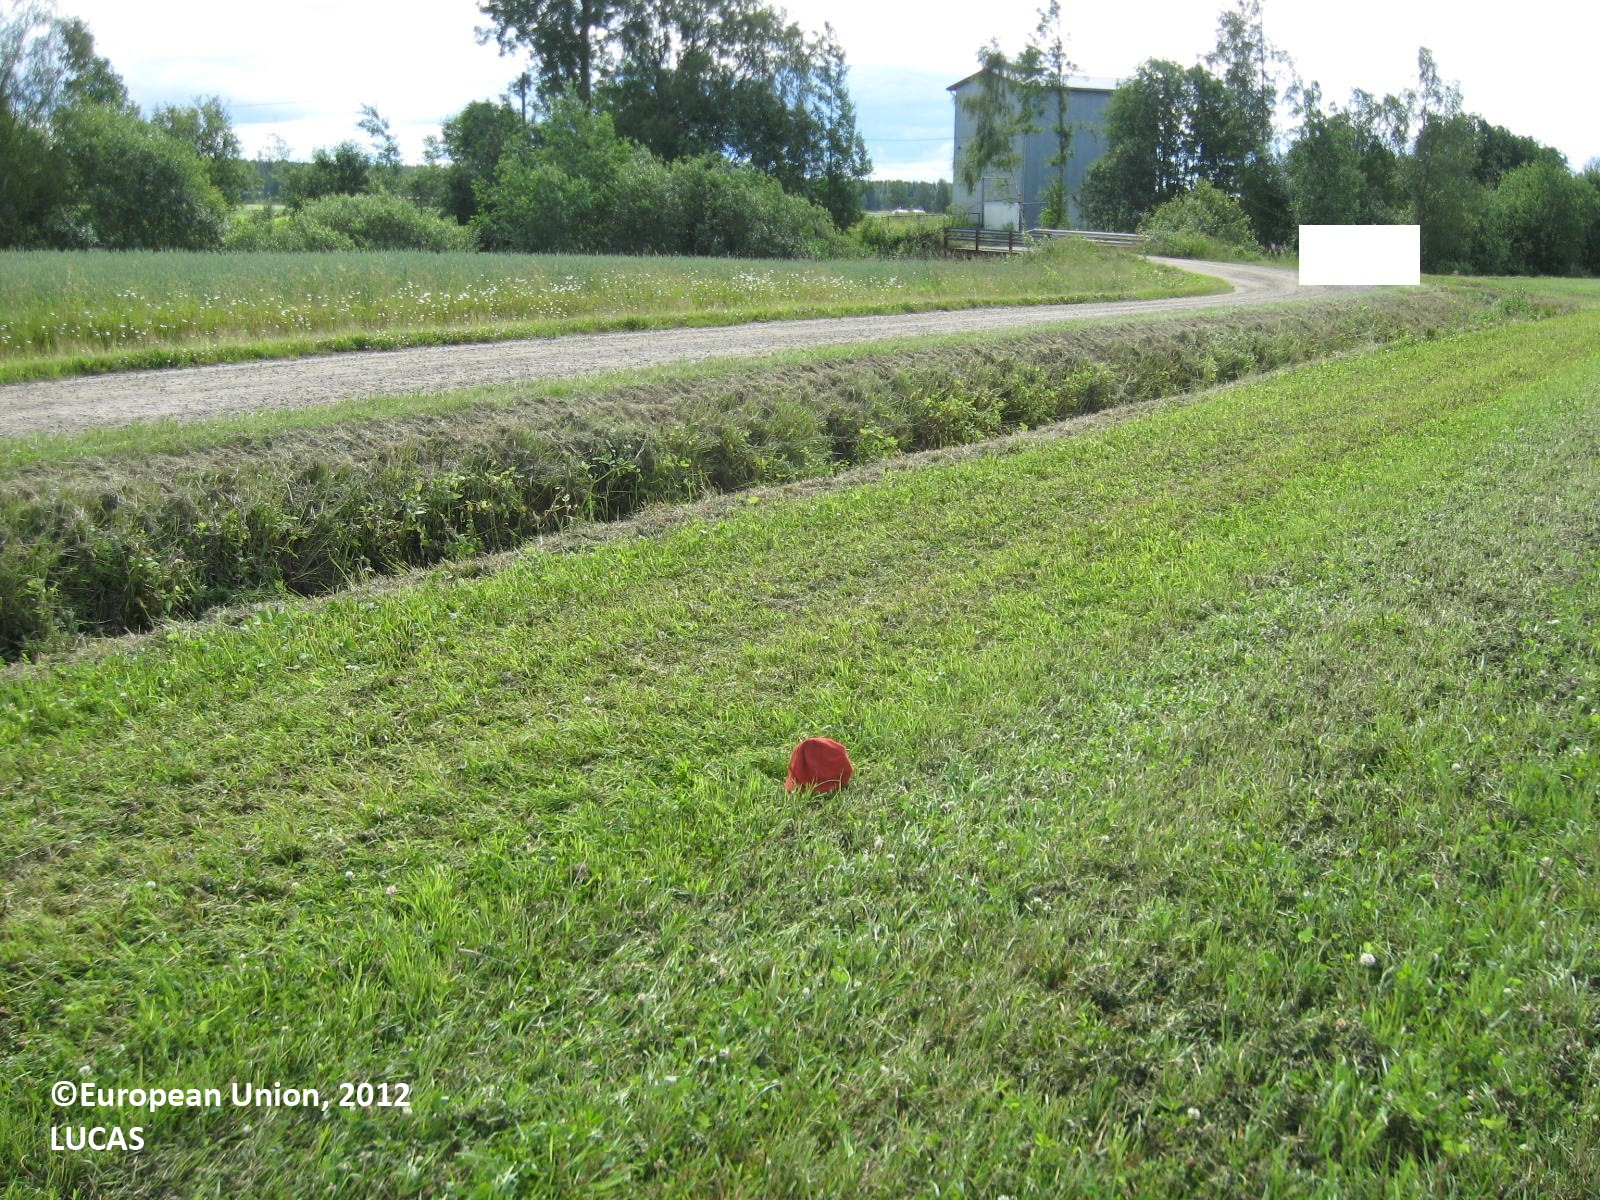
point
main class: Cropland
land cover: Clovers
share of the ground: > 75 %
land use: Agriculture (excluding fallow land and kitchen gardens)
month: July
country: FI
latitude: 62.3292
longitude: 21.5689
